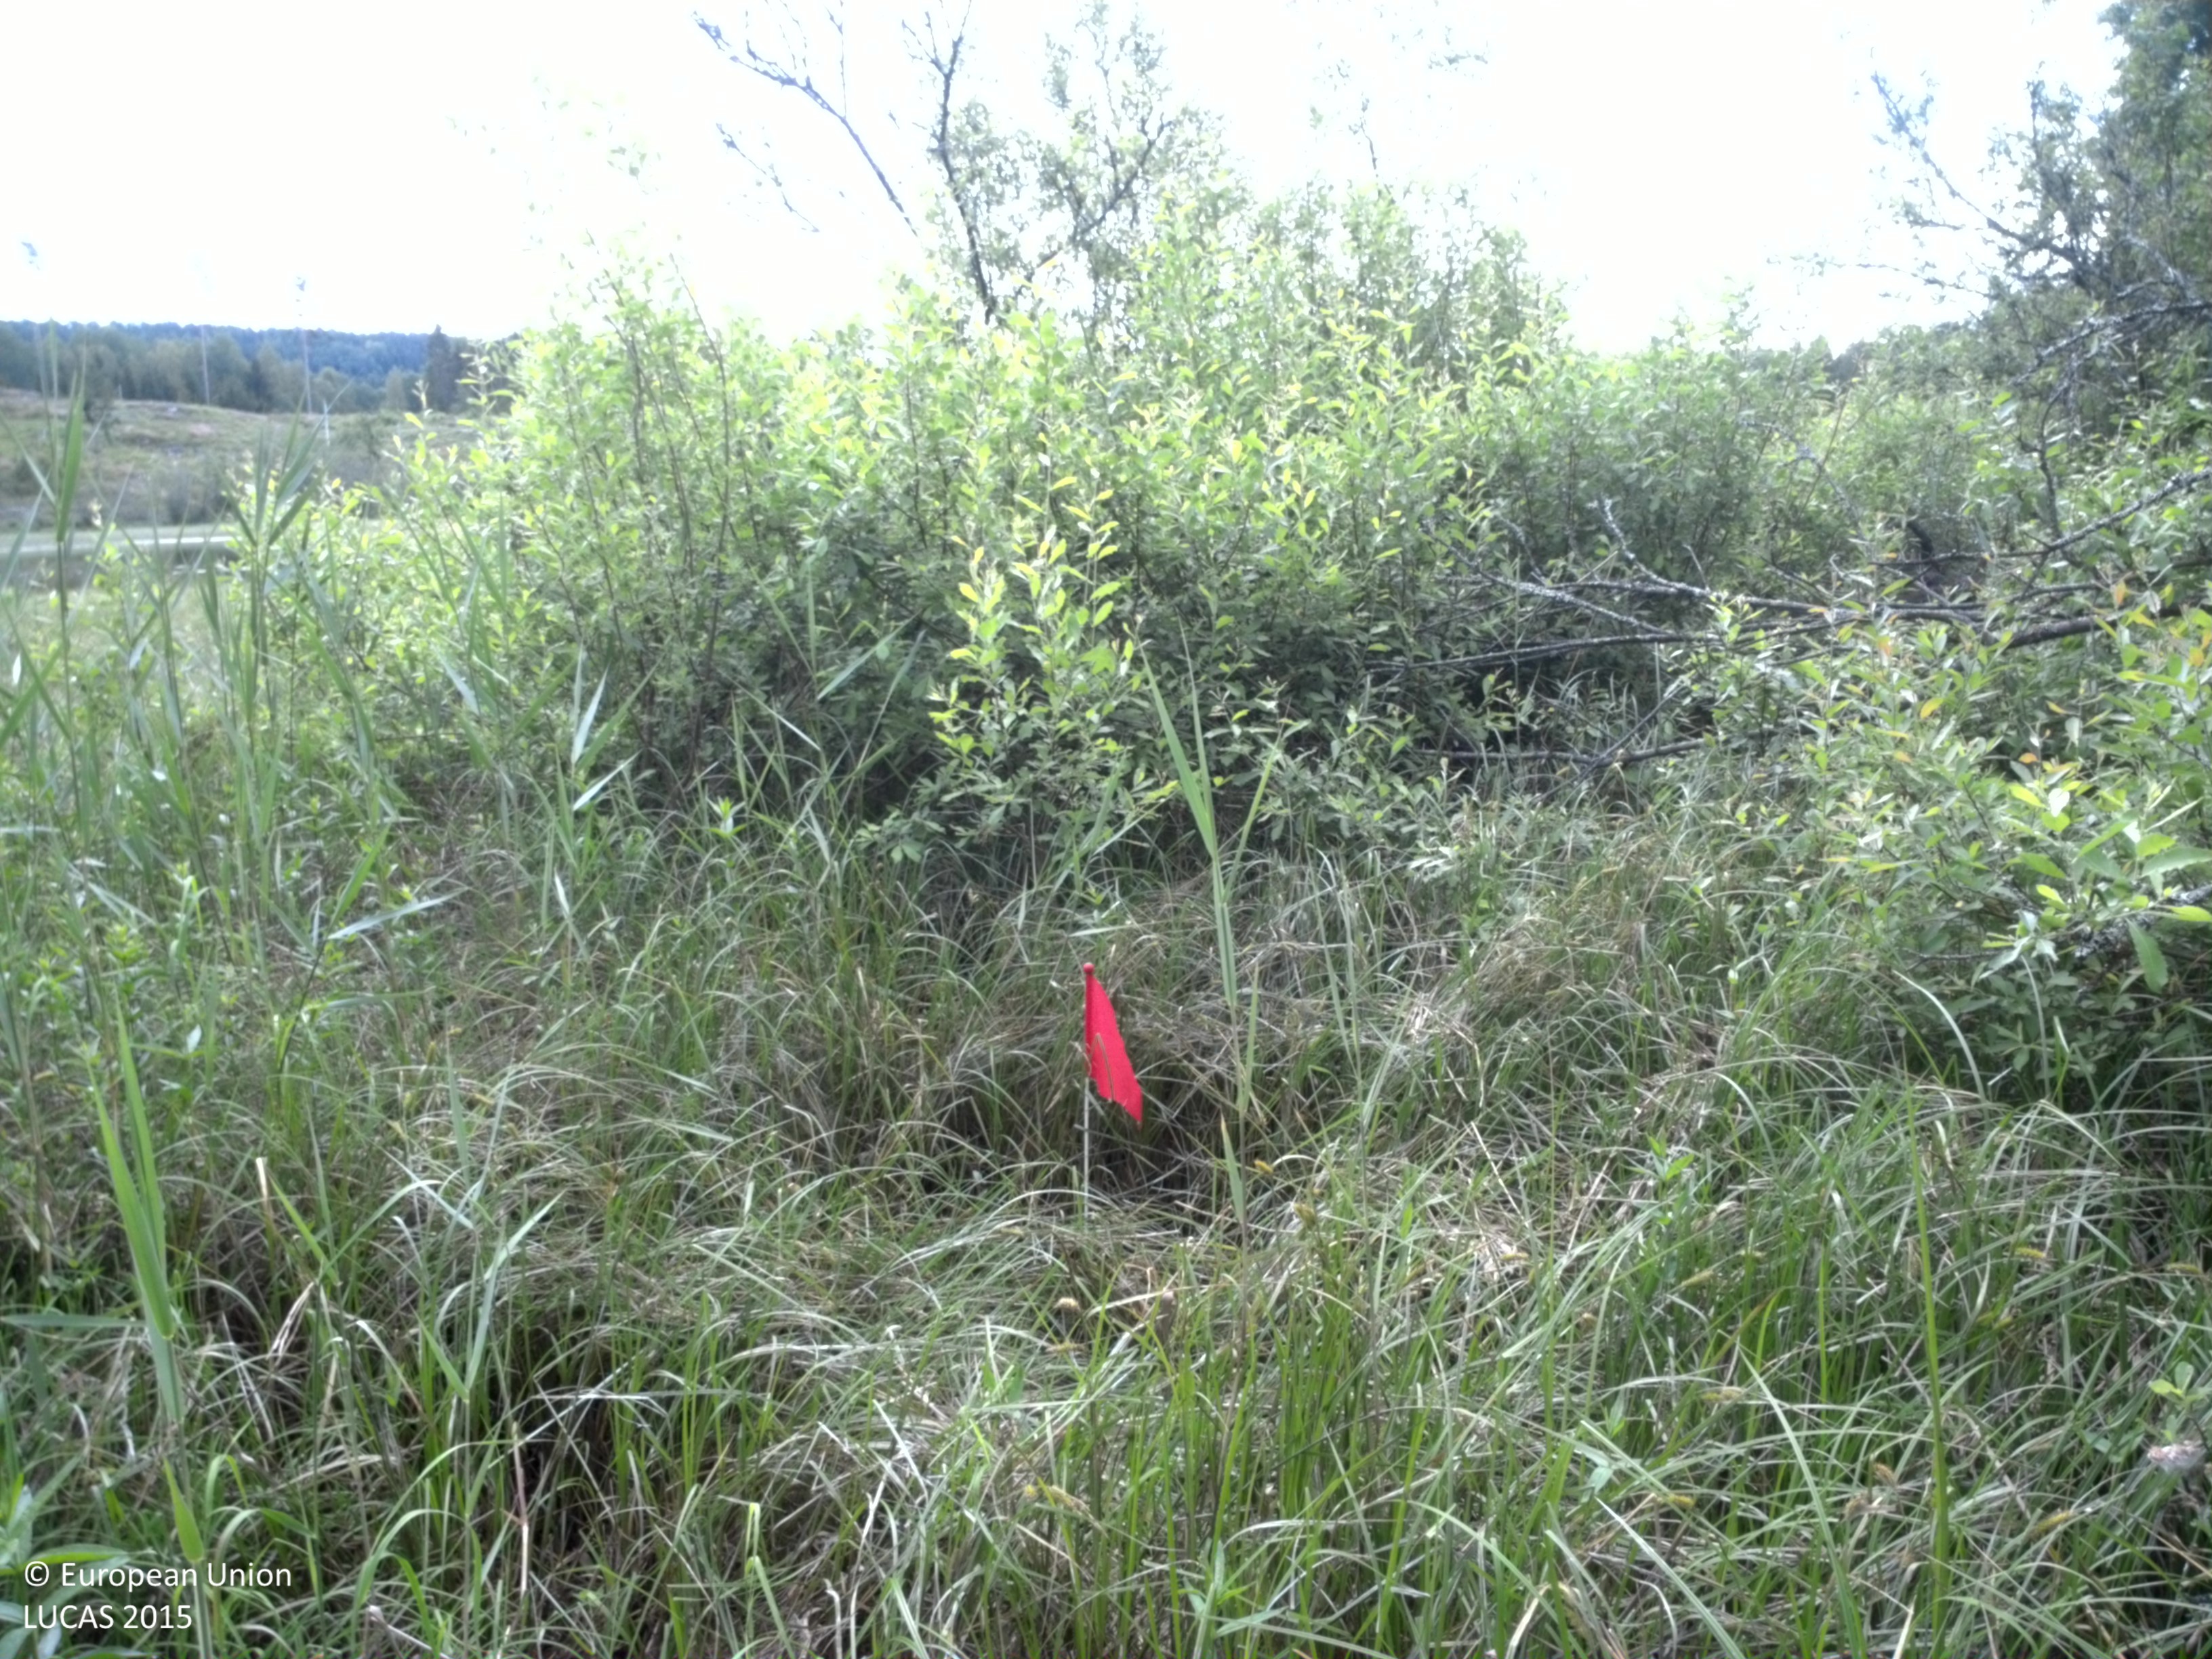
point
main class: Shrubland
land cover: Shrubland with sparse tree cover
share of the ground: 50 - 75 %
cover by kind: shrubs 55 %, herbaceous plants 40 %, broadleaved forest trees 5 %
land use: Semi-natural and natural areas not in use
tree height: < 5 m
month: July
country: SE
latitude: 59.8062
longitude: 12.0087
